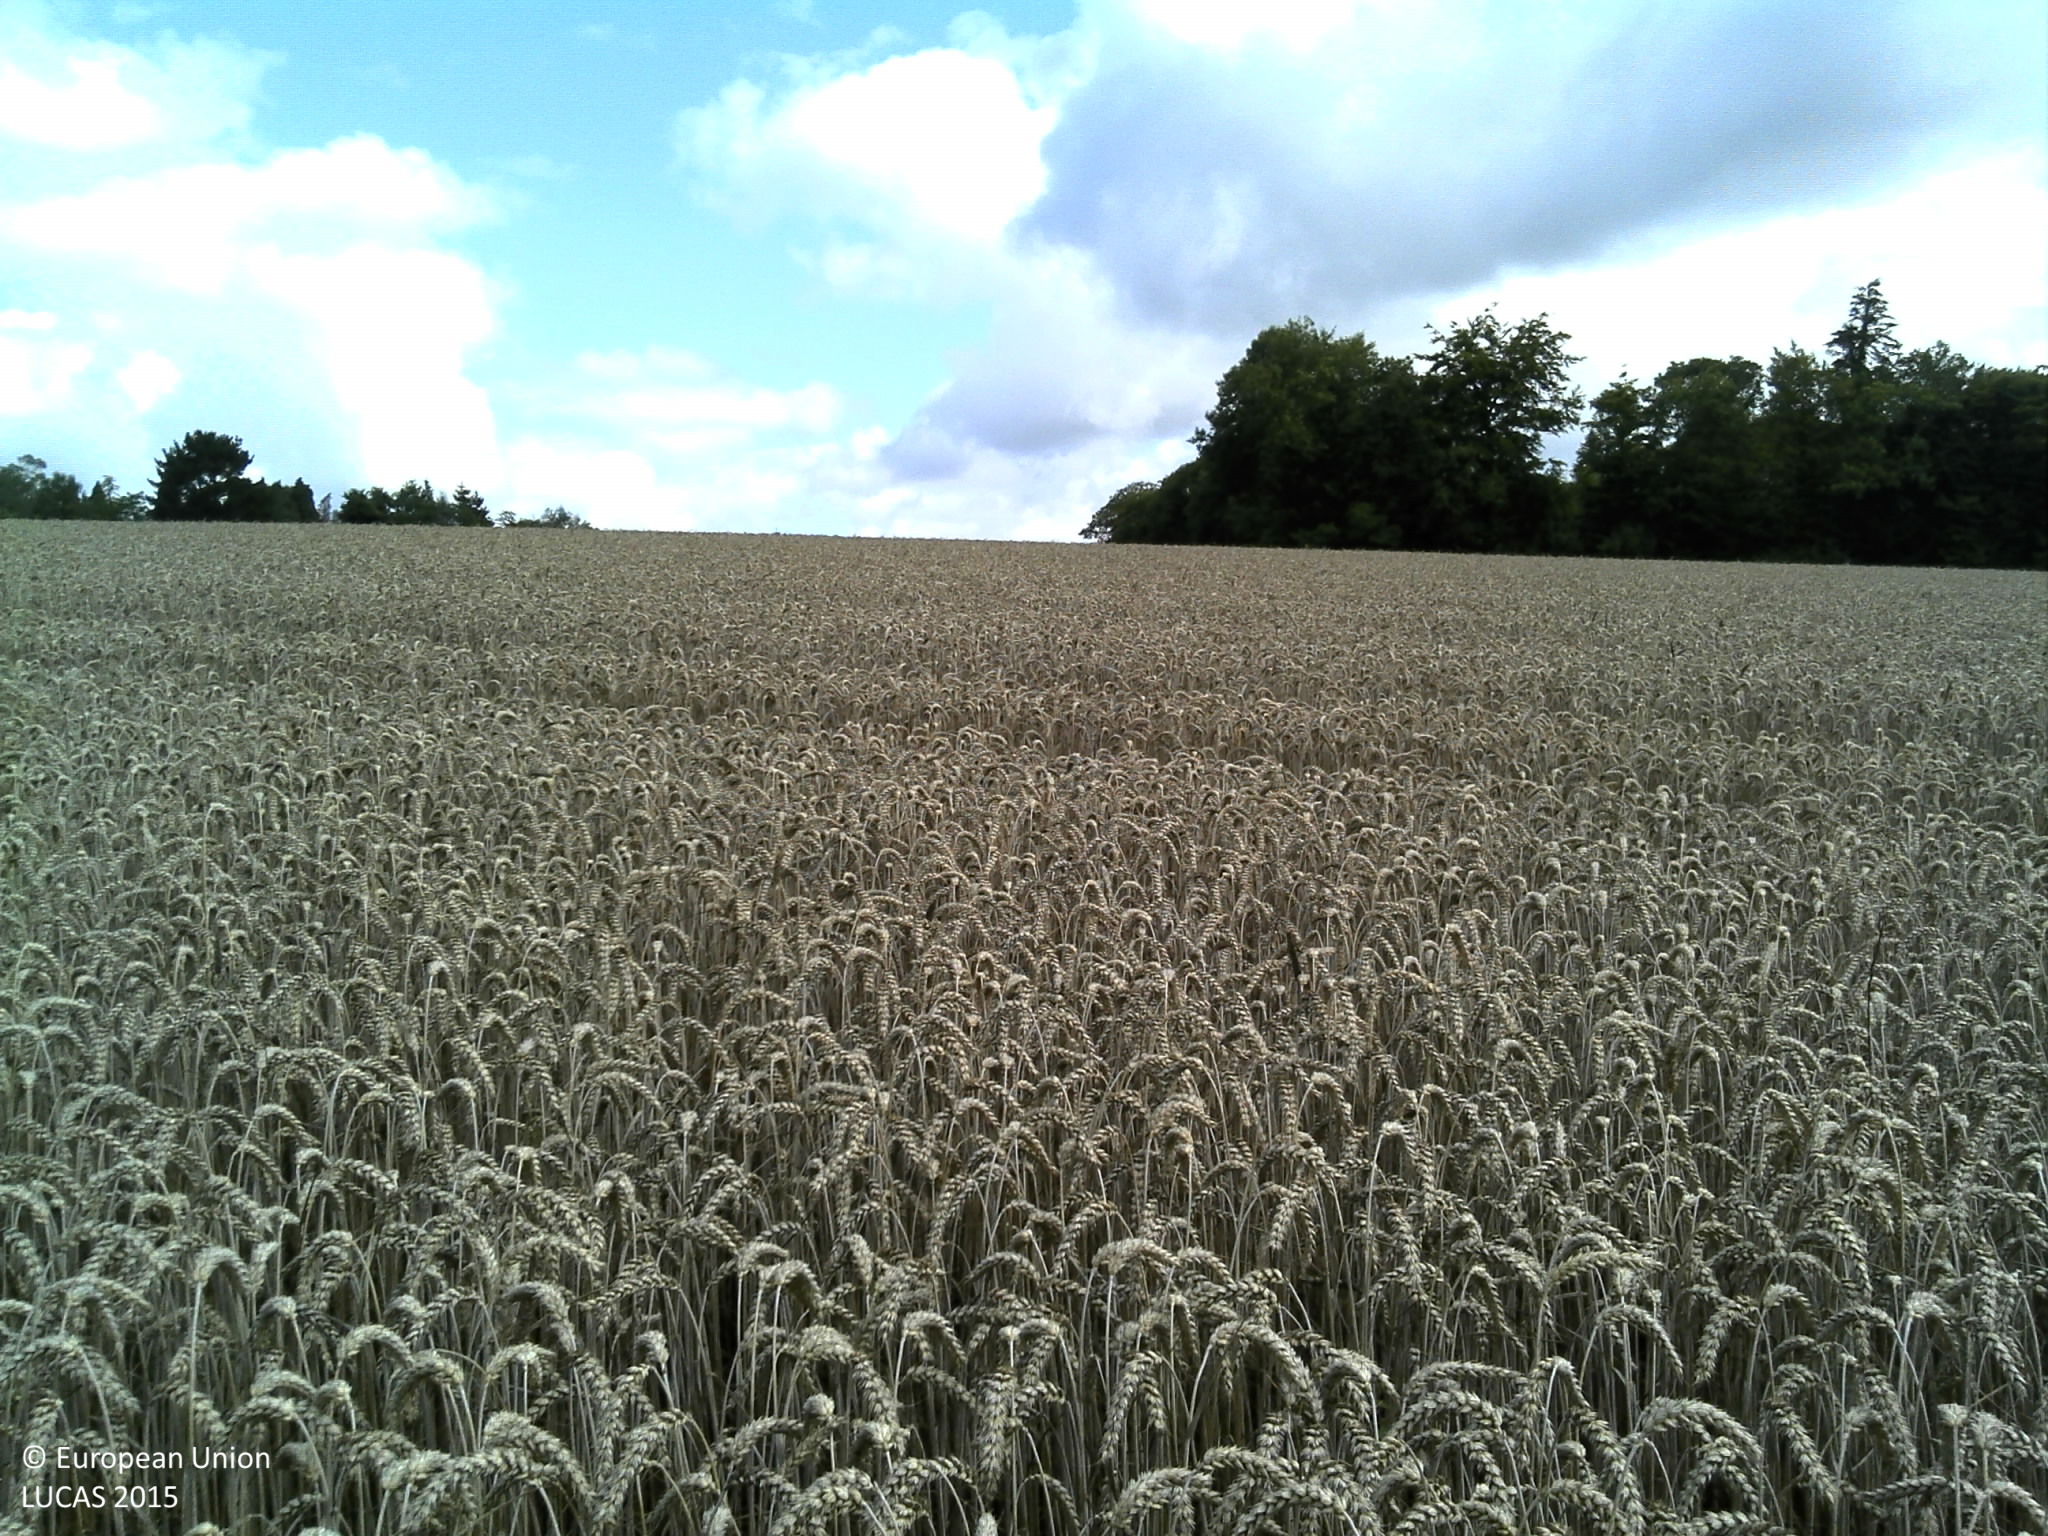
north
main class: Cropland
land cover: Common wheat
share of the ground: > 75 %
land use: Agriculture (excluding fallow land and kitchen gardens)
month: July
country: FR
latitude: 48.3456
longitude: -3.7238
